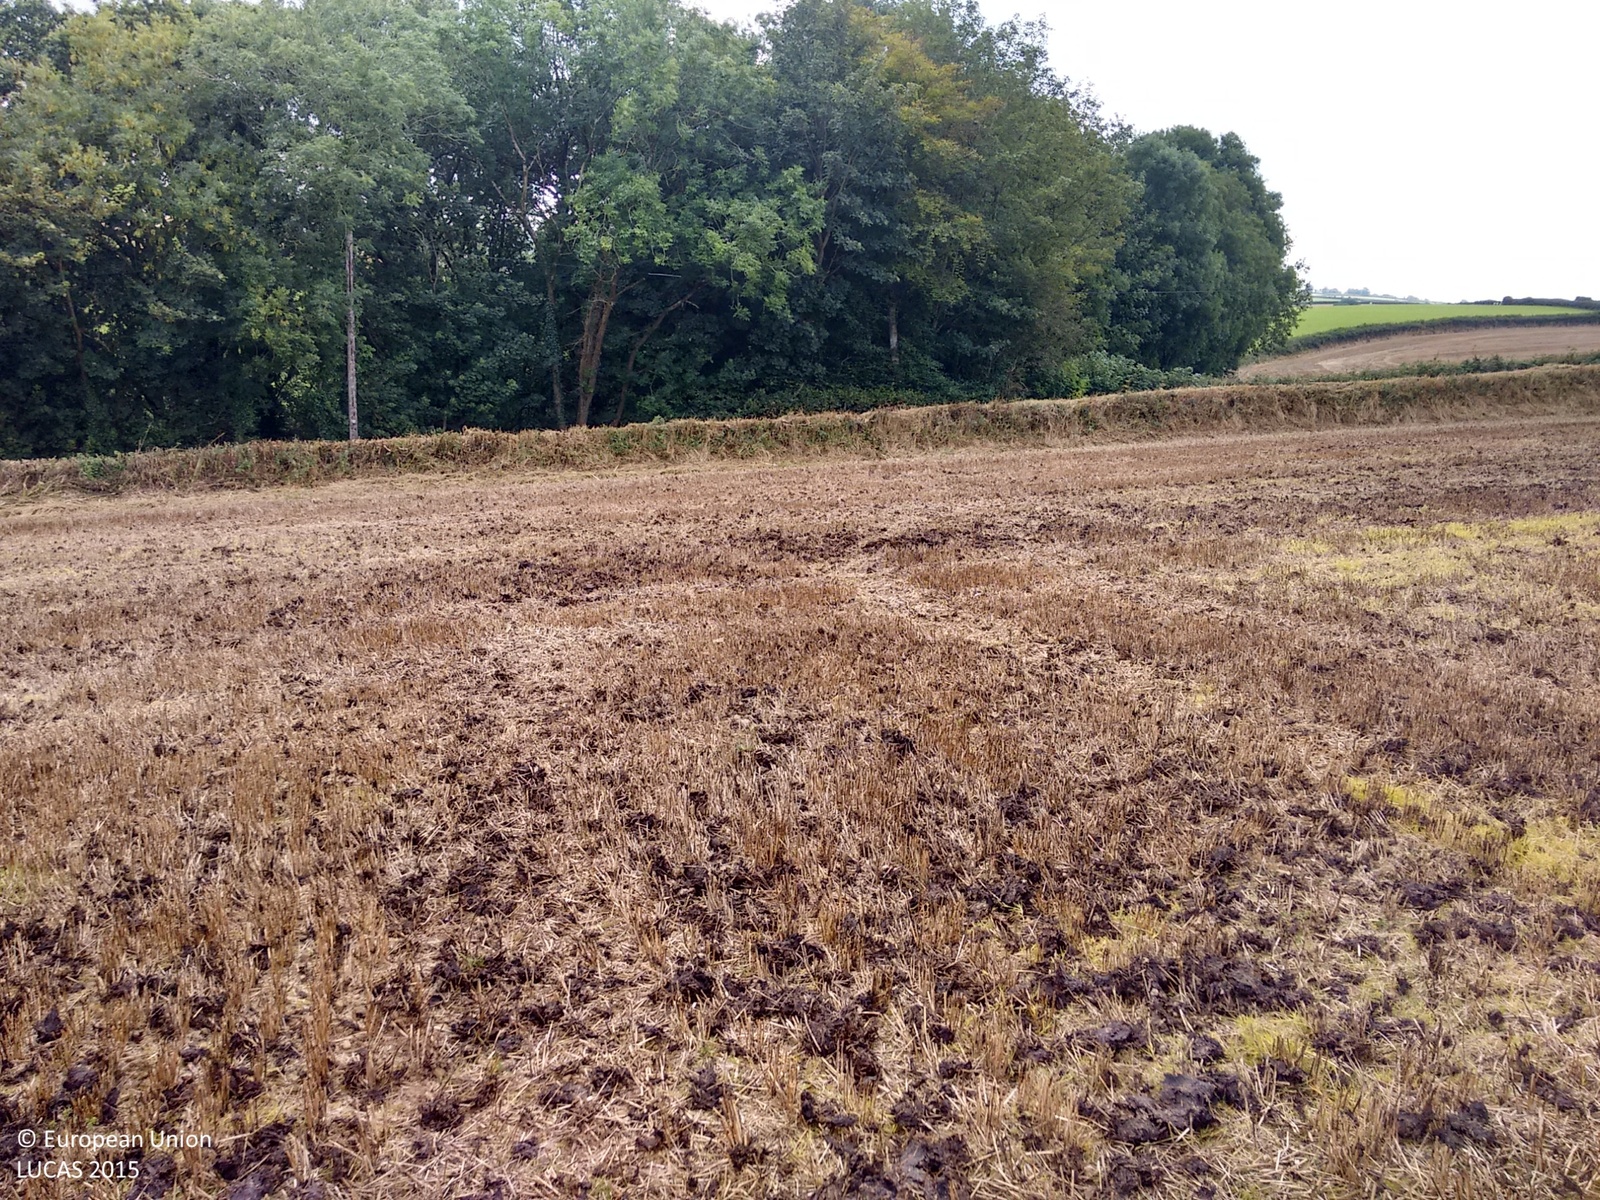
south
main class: Cropland
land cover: Barley
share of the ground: 50 - 75 %
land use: Agriculture (excluding fallow land and kitchen gardens)
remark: Harvested field
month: September
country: GB
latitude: 50.9054
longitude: -4.2781
